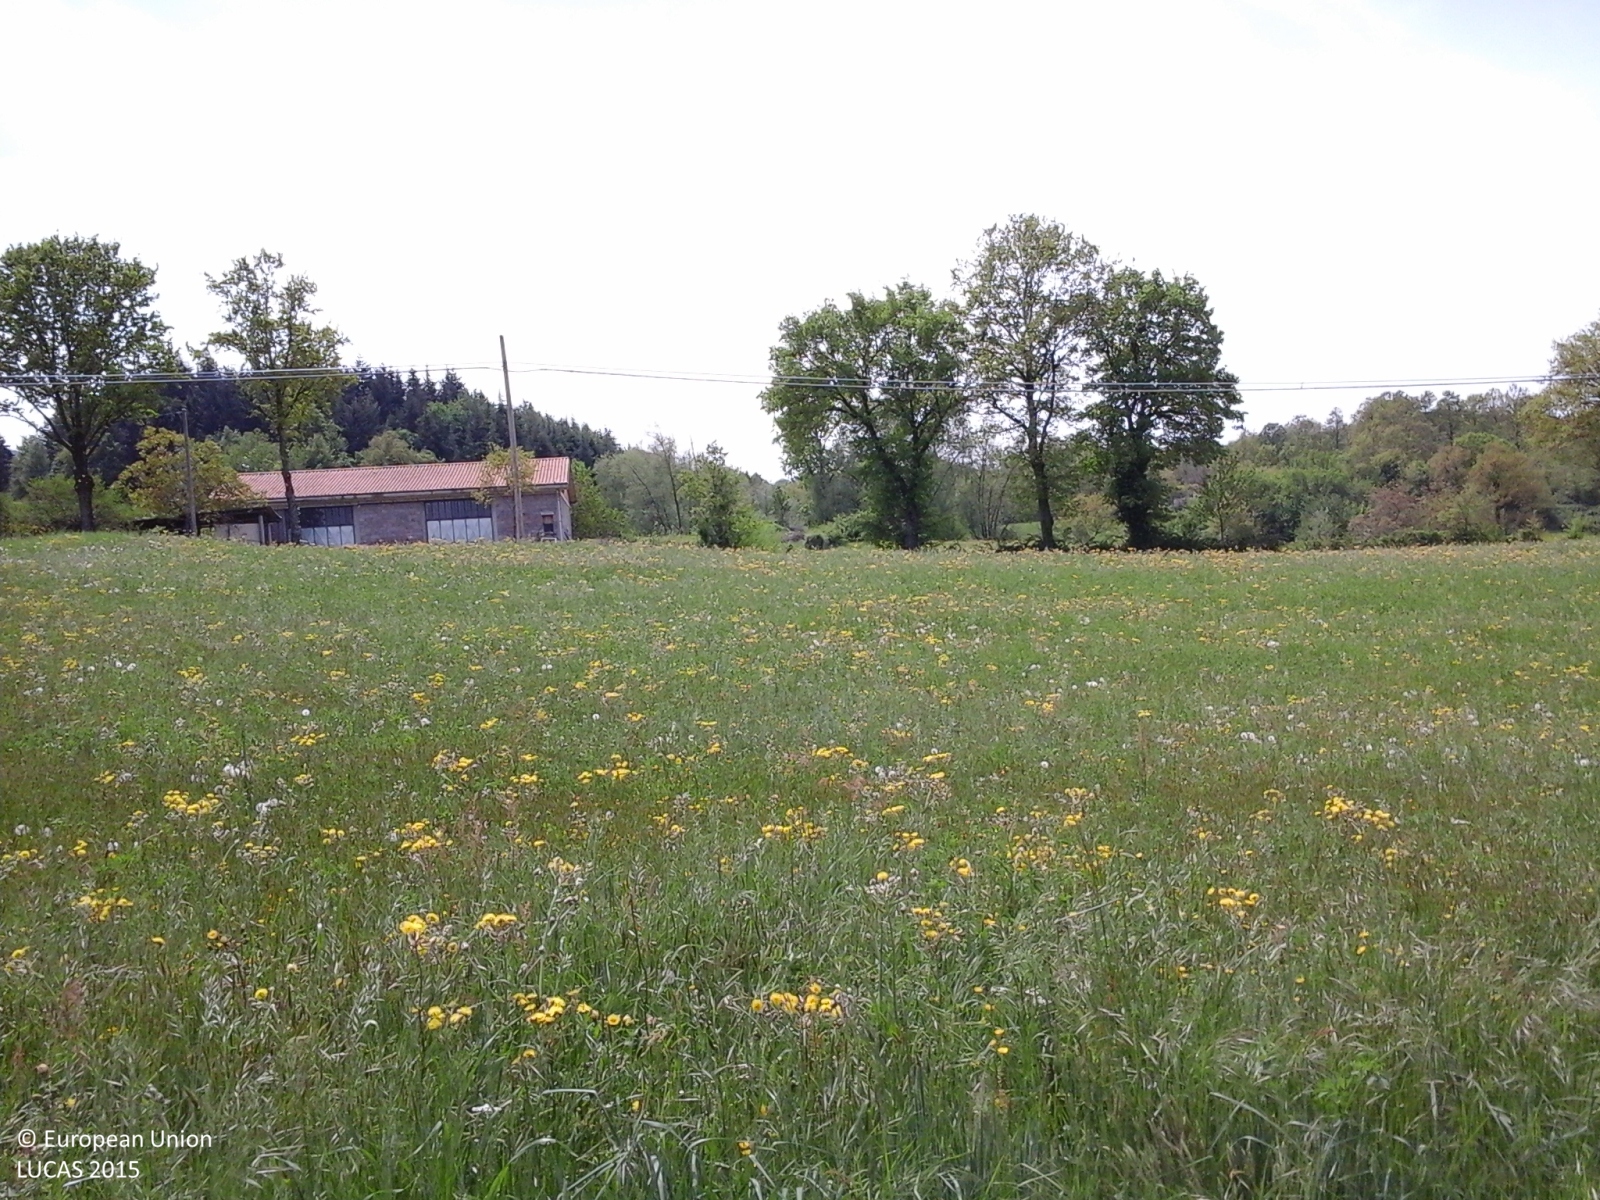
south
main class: Cropland
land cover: Barley
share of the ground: > 75 %
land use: Agriculture (excluding fallow land and kitchen gardens)
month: May
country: IT
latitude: 43.8622
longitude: 11.9982
